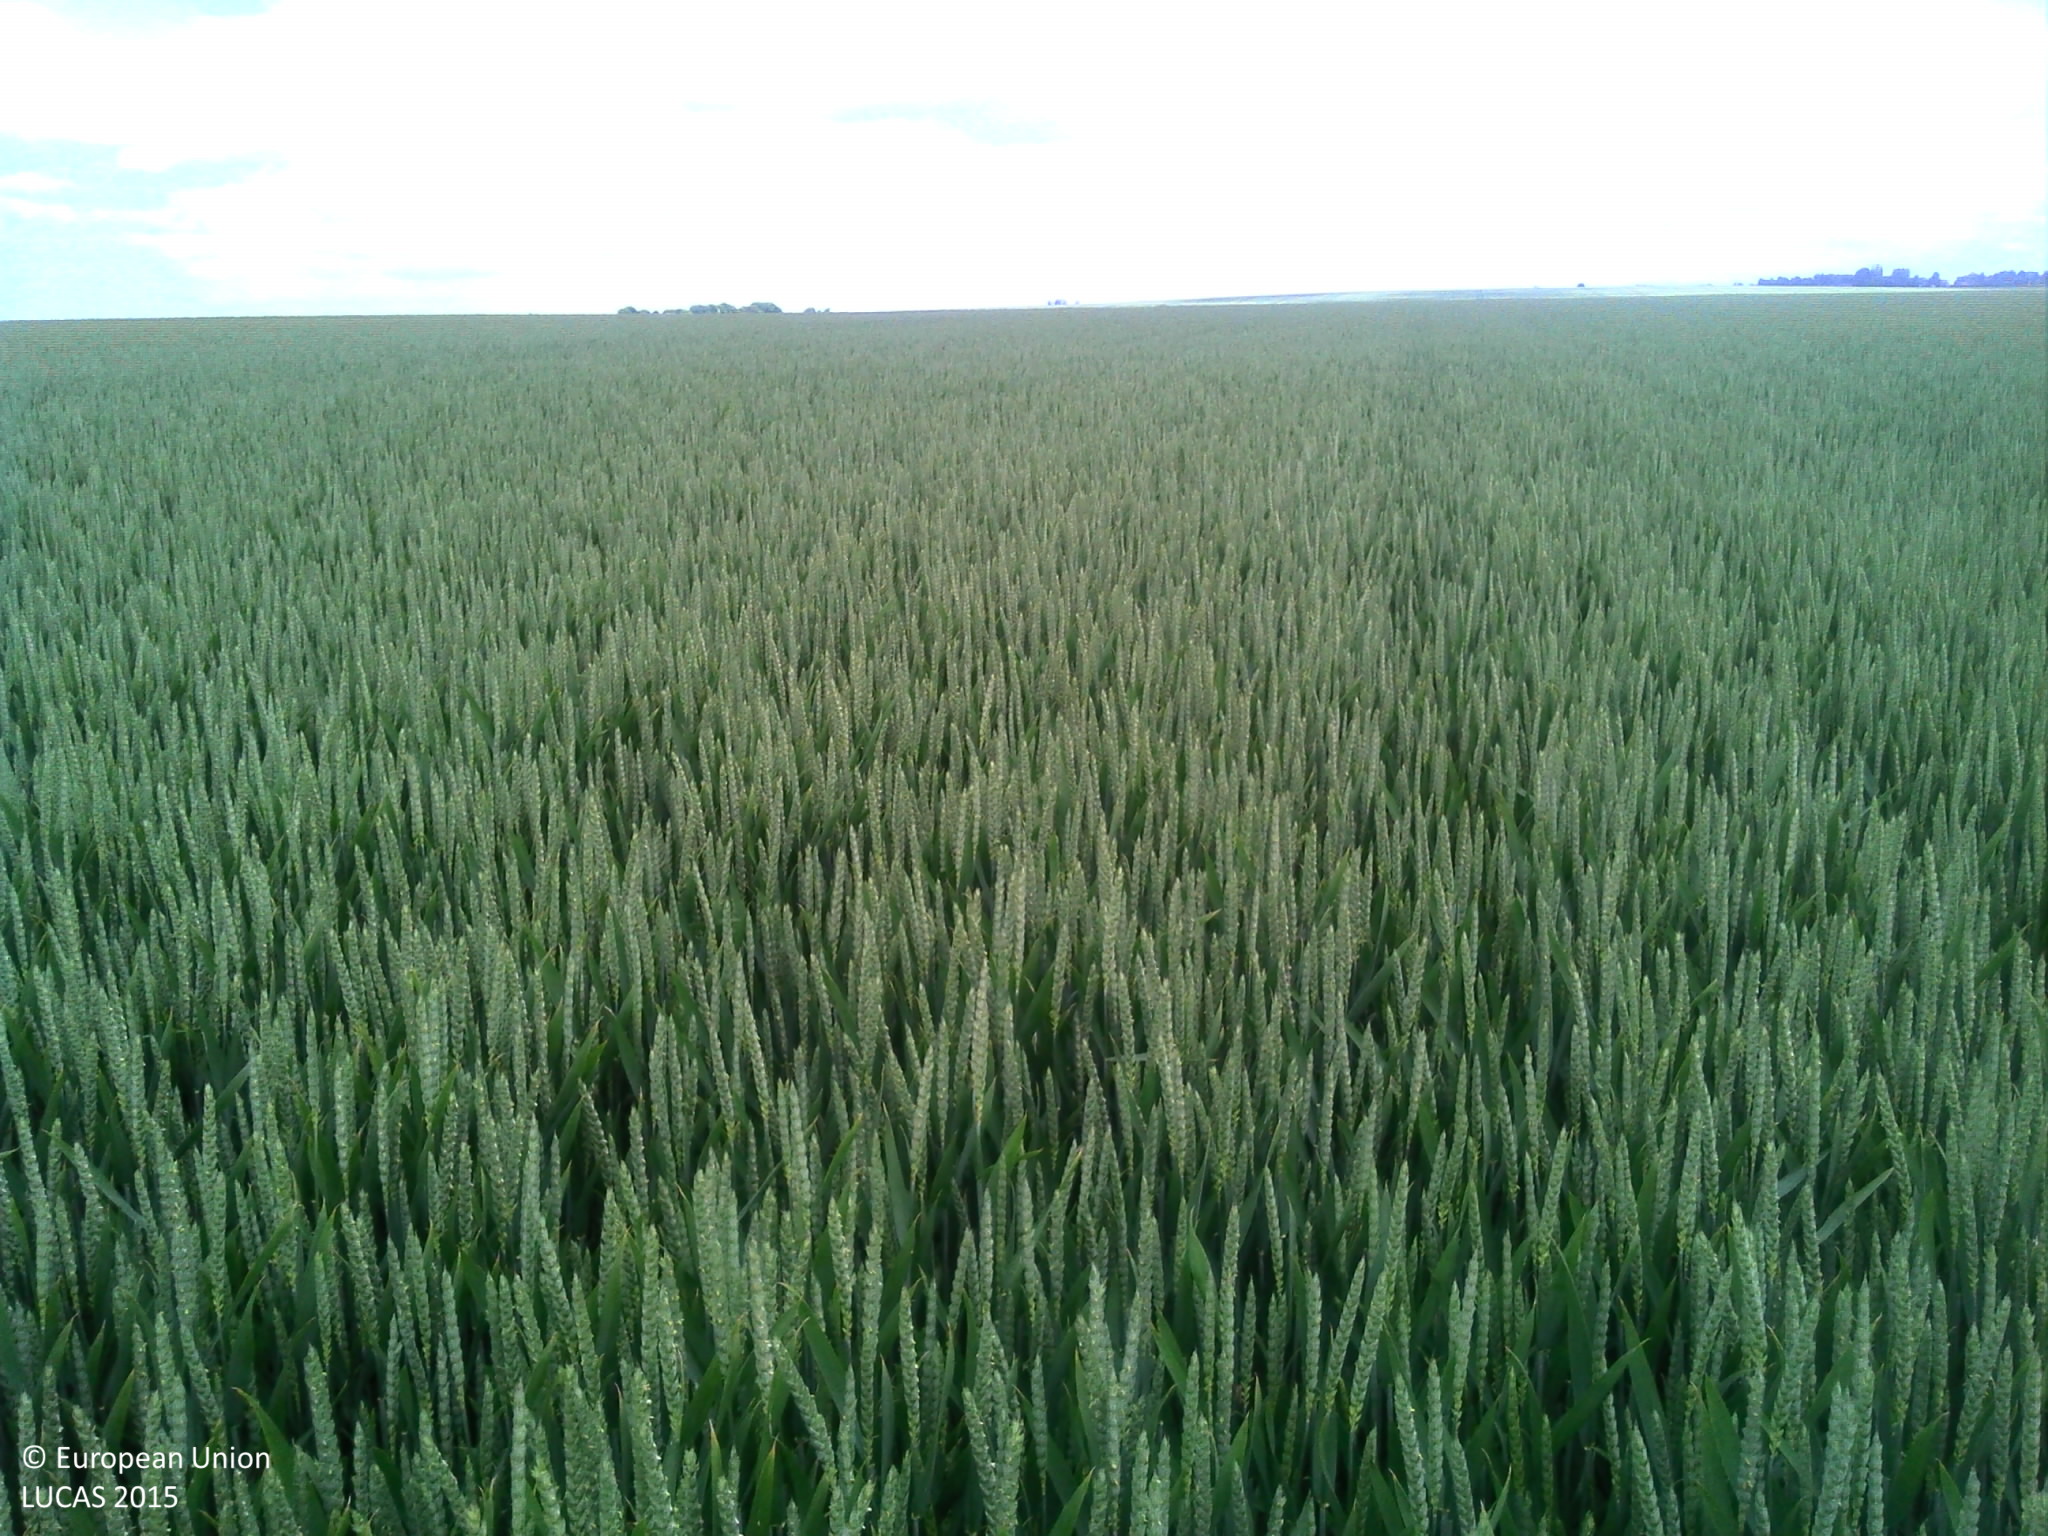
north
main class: Cropland
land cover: Common wheat
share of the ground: > 75 %
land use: Agriculture (excluding fallow land and kitchen gardens)
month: June
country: FR
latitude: 49.7502
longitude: 3.2602
